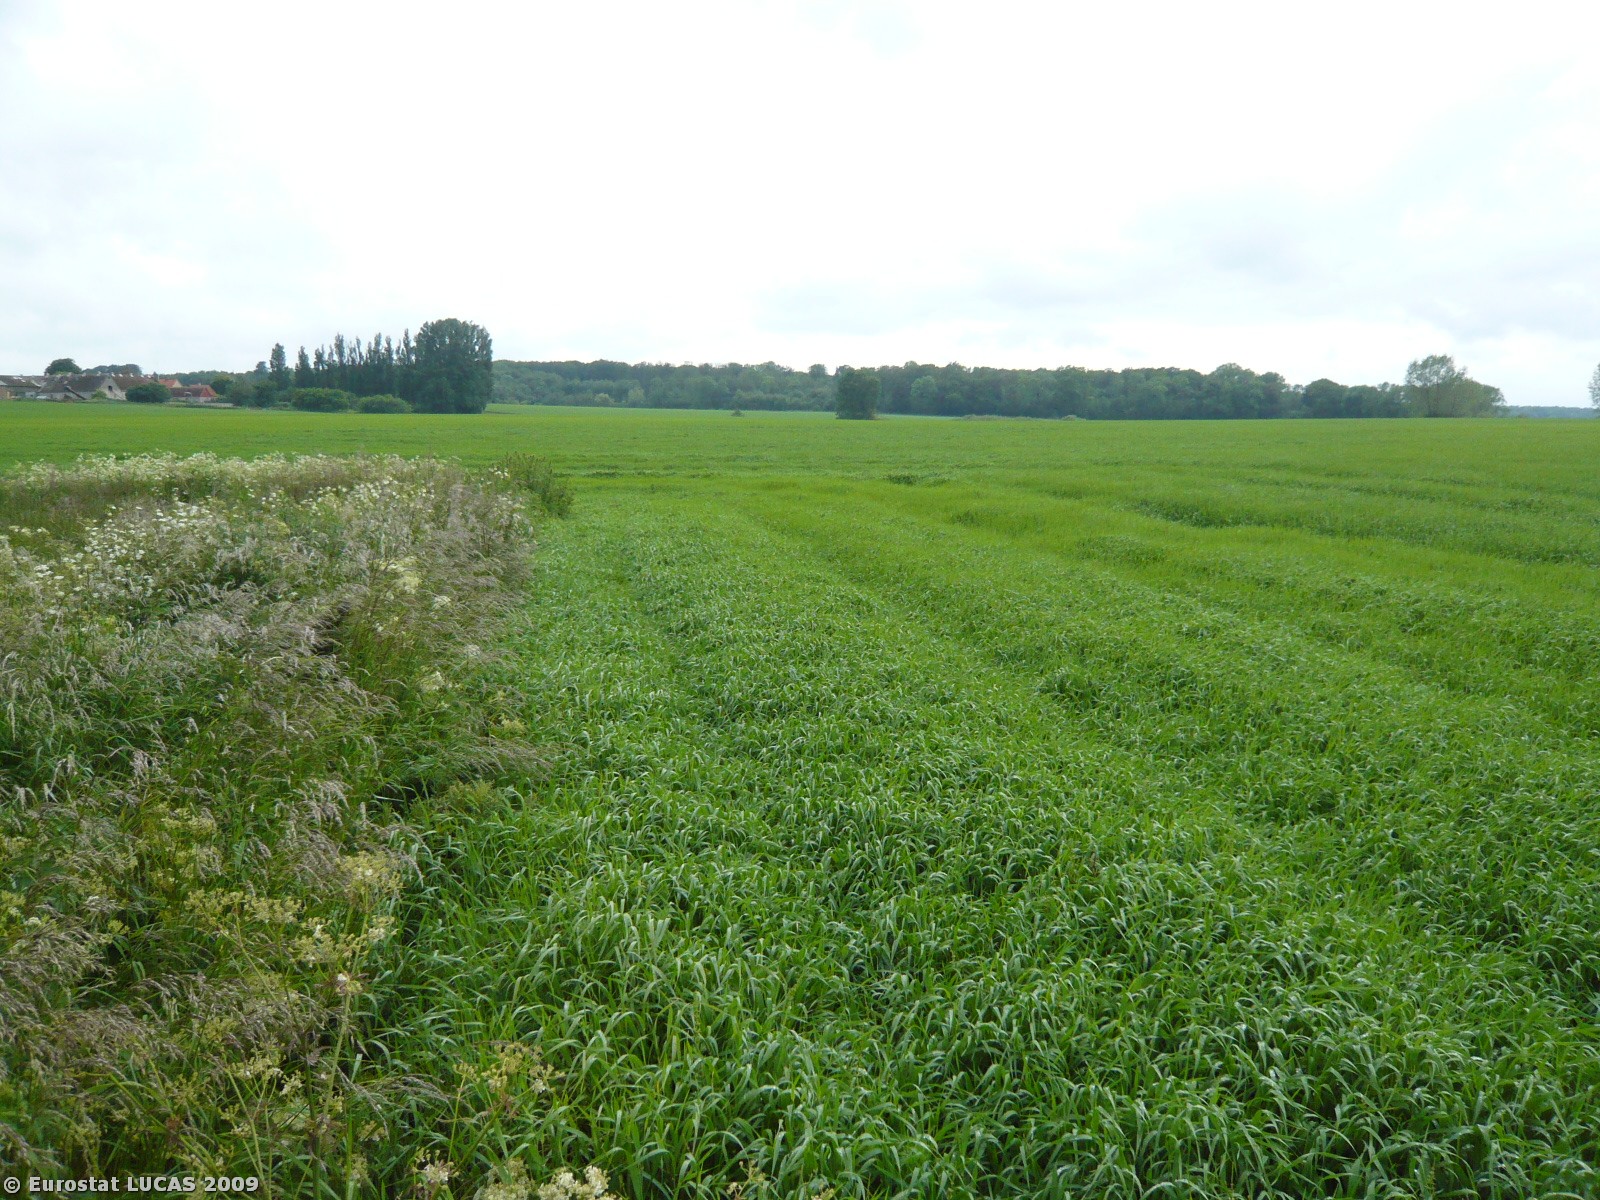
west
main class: Cropland
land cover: Barley
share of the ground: > 75 %
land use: Agriculture (excluding fallow land and kitchen gardens)
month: June
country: DK
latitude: 54.9149
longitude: 11.9175
